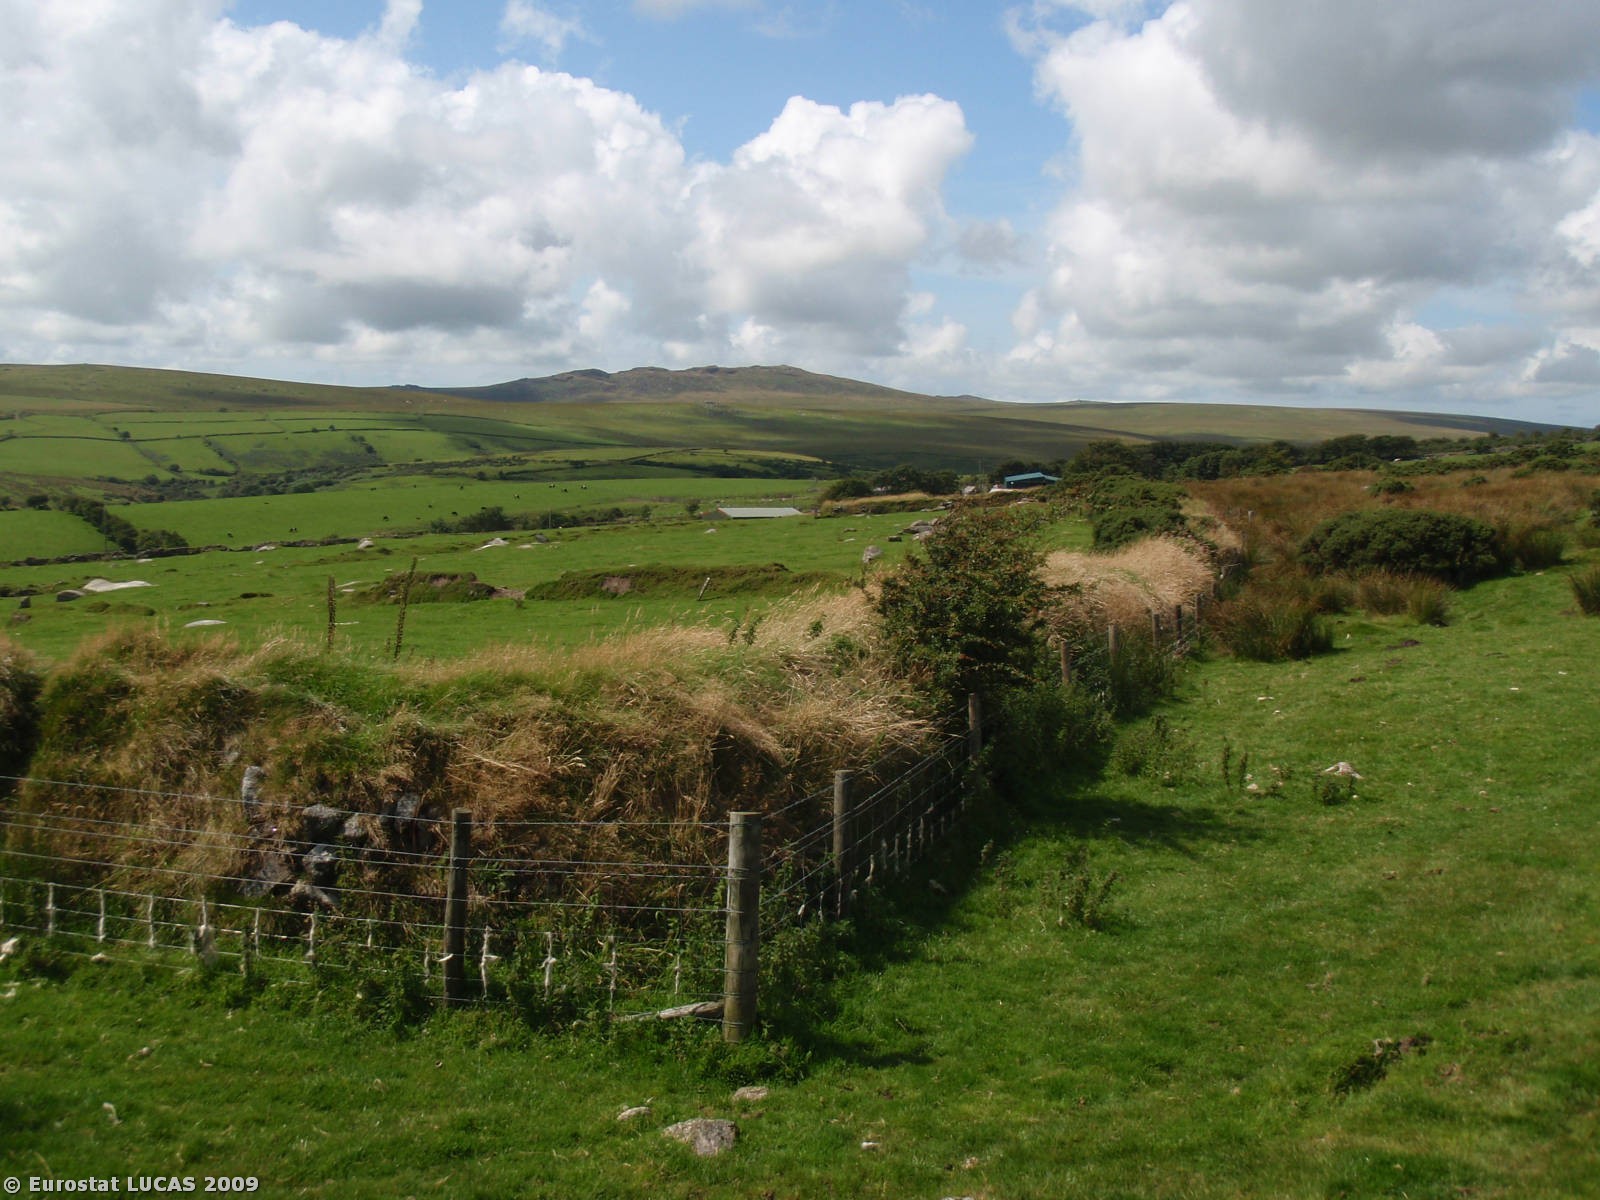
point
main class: Grassland
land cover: Grassland without tree/shrub cover
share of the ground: > 75 %
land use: Agriculture (excluding fallow land and kitchen gardens)
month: August
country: GB
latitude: 50.5783
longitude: -4.5522
